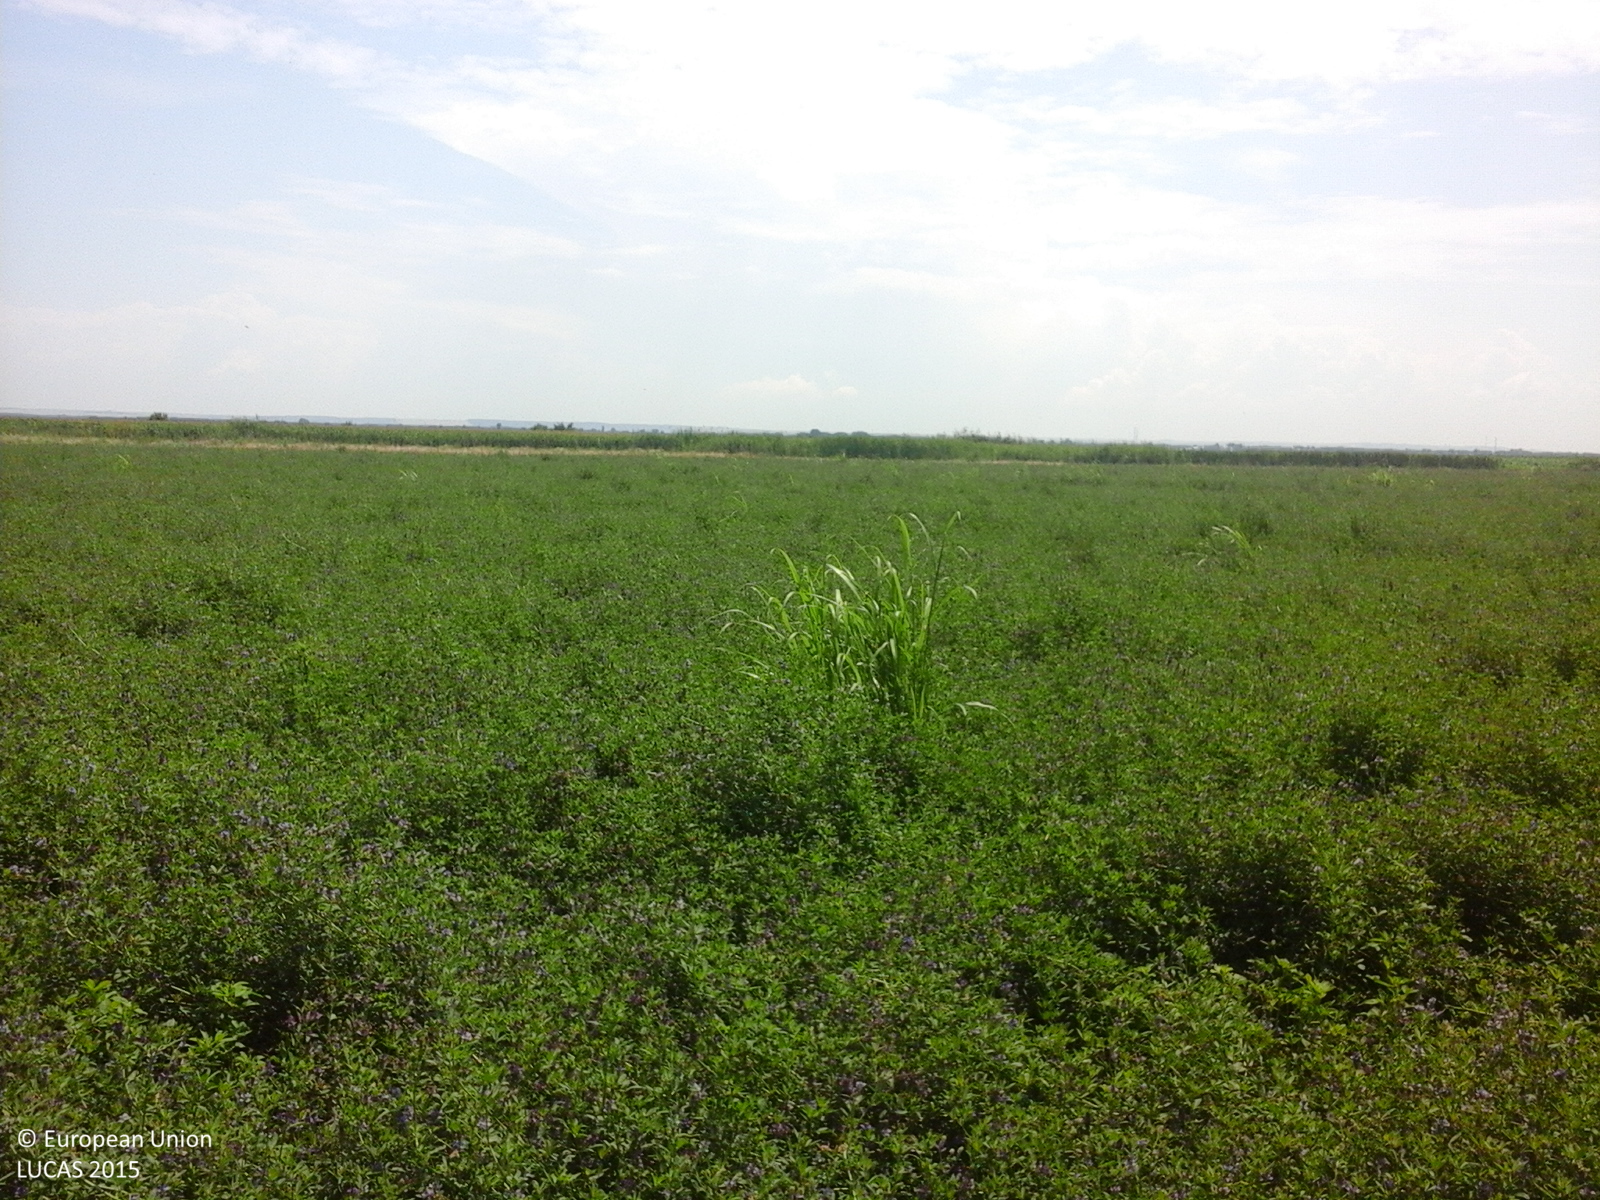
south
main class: Cropland
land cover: Lucerne
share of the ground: > 75 %
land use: Agriculture (excluding fallow land and kitchen gardens)
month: July
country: RO
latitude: 43.9954
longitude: 26.0227
